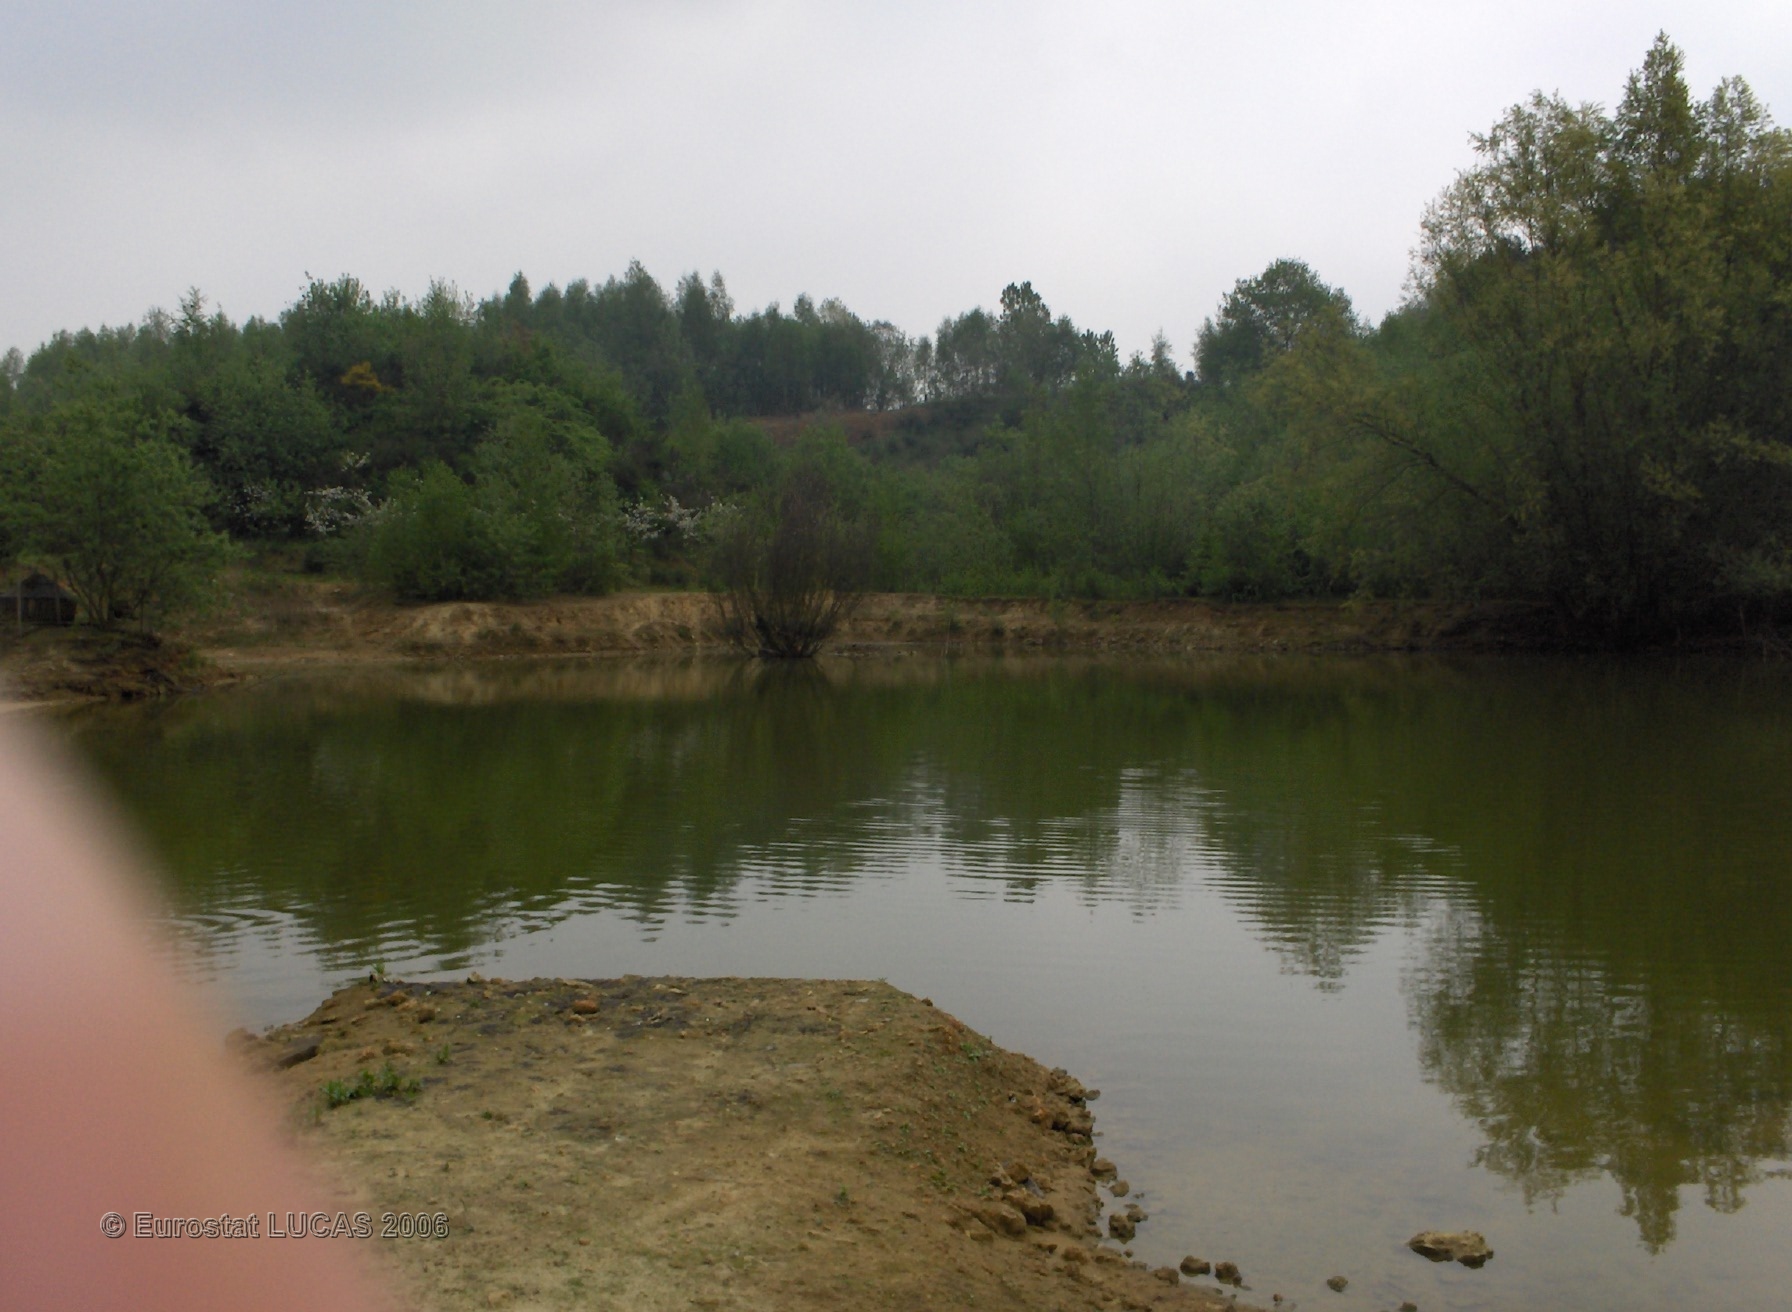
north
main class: Water areas
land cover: Inland water bodies
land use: Unused
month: May
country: BE
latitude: 50.5591
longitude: 4.5613
